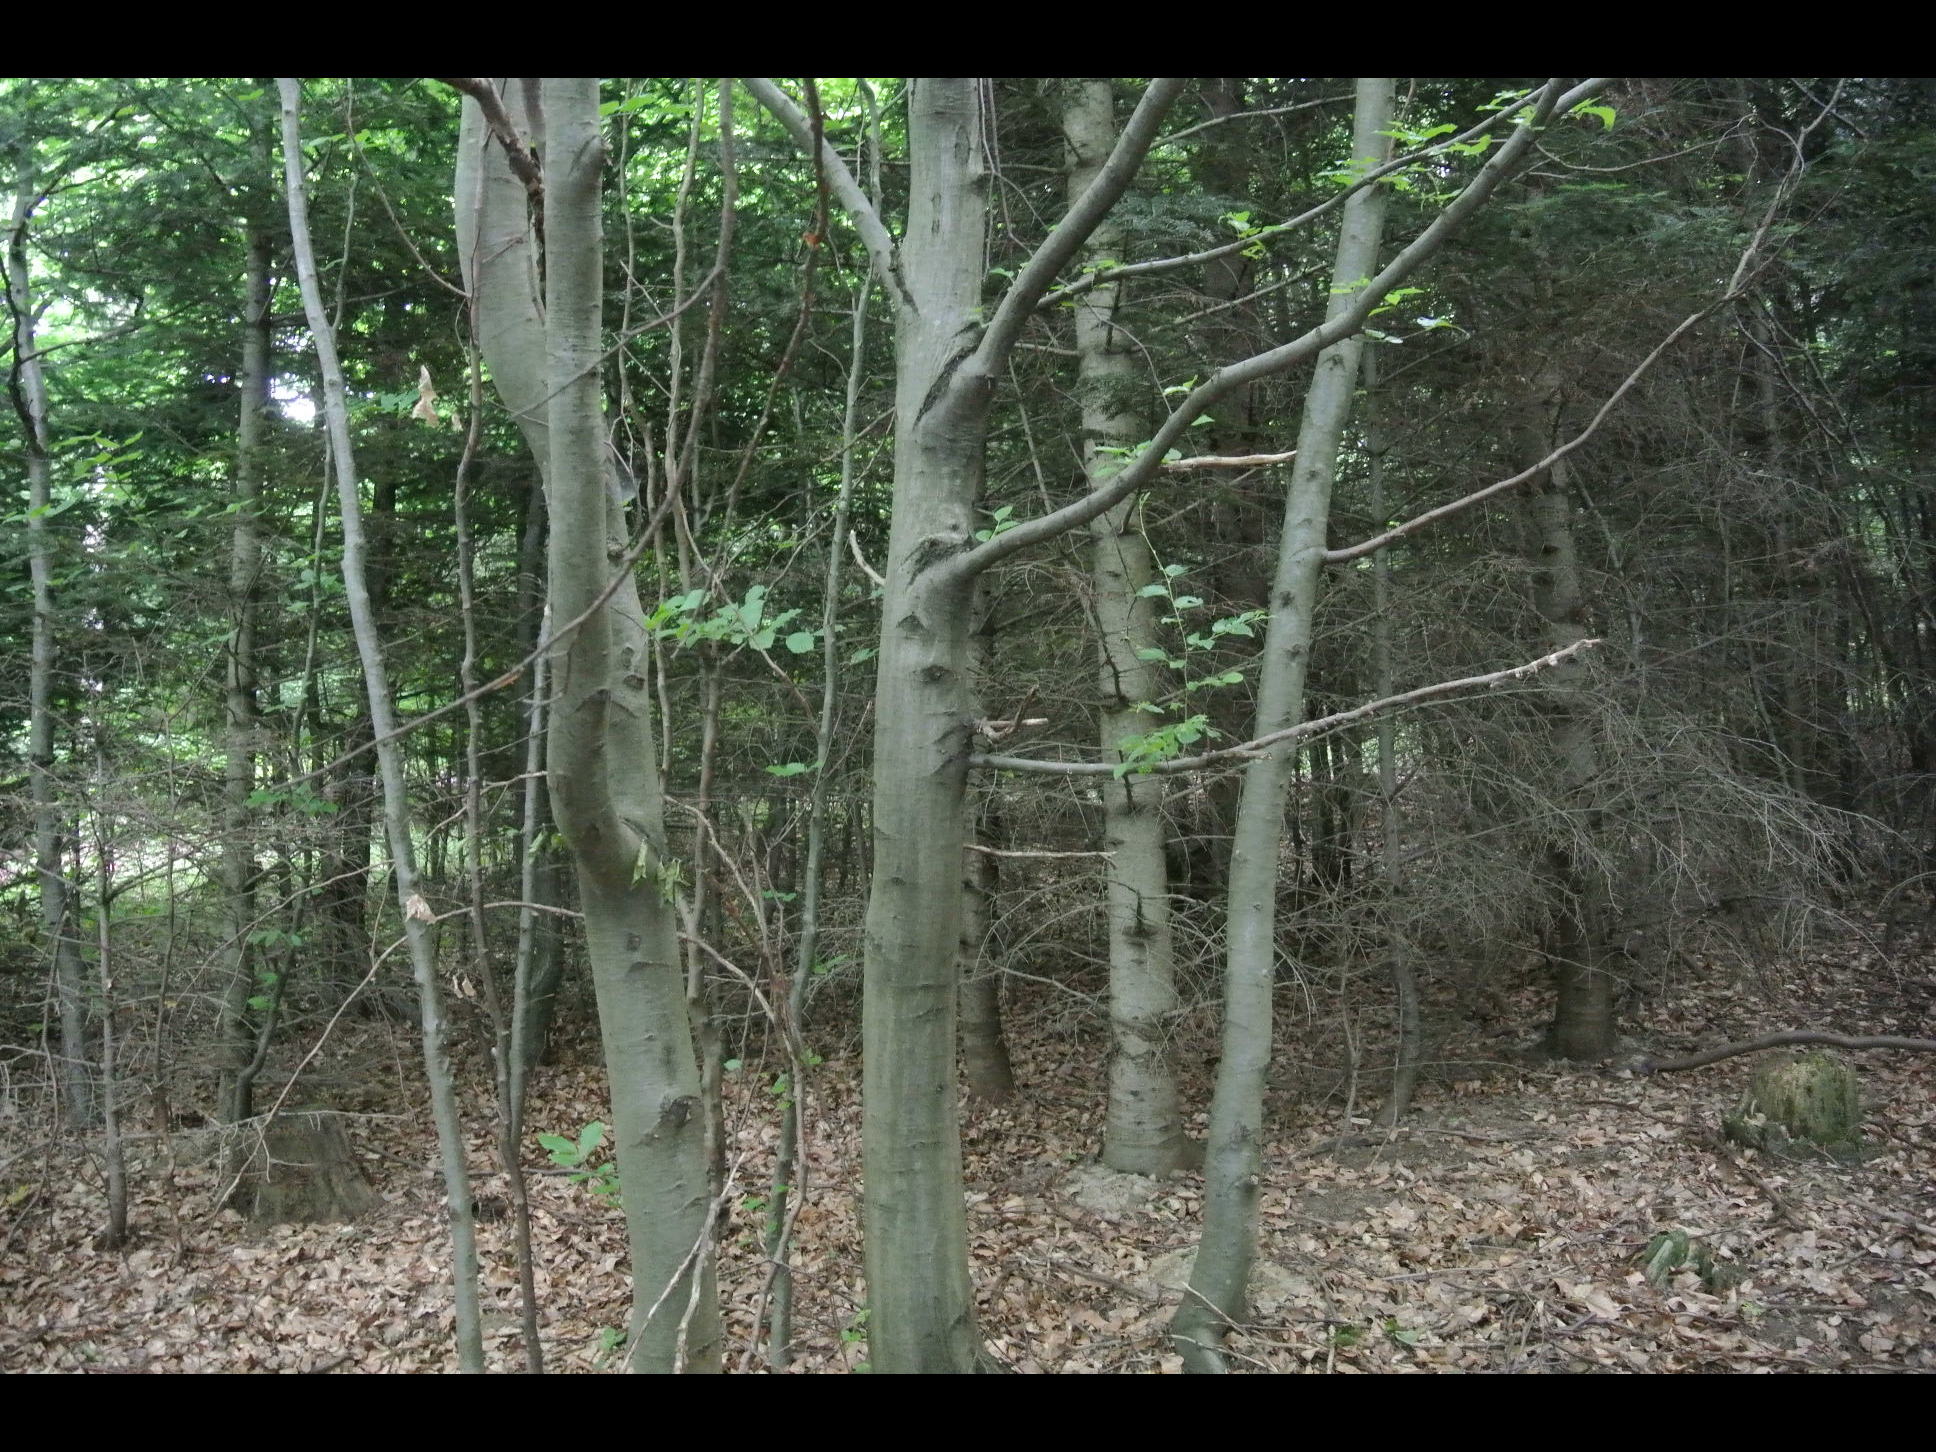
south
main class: Woodland
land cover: Spruce dominated mixed woodland
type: alpine coniferous forest
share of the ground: > 75 %
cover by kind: broadleaved forest trees 75 %, coniferous forest trees 25 %
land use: Forestry
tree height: > 5 m
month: June
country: AT
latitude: 48.0512
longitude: 16.1618
